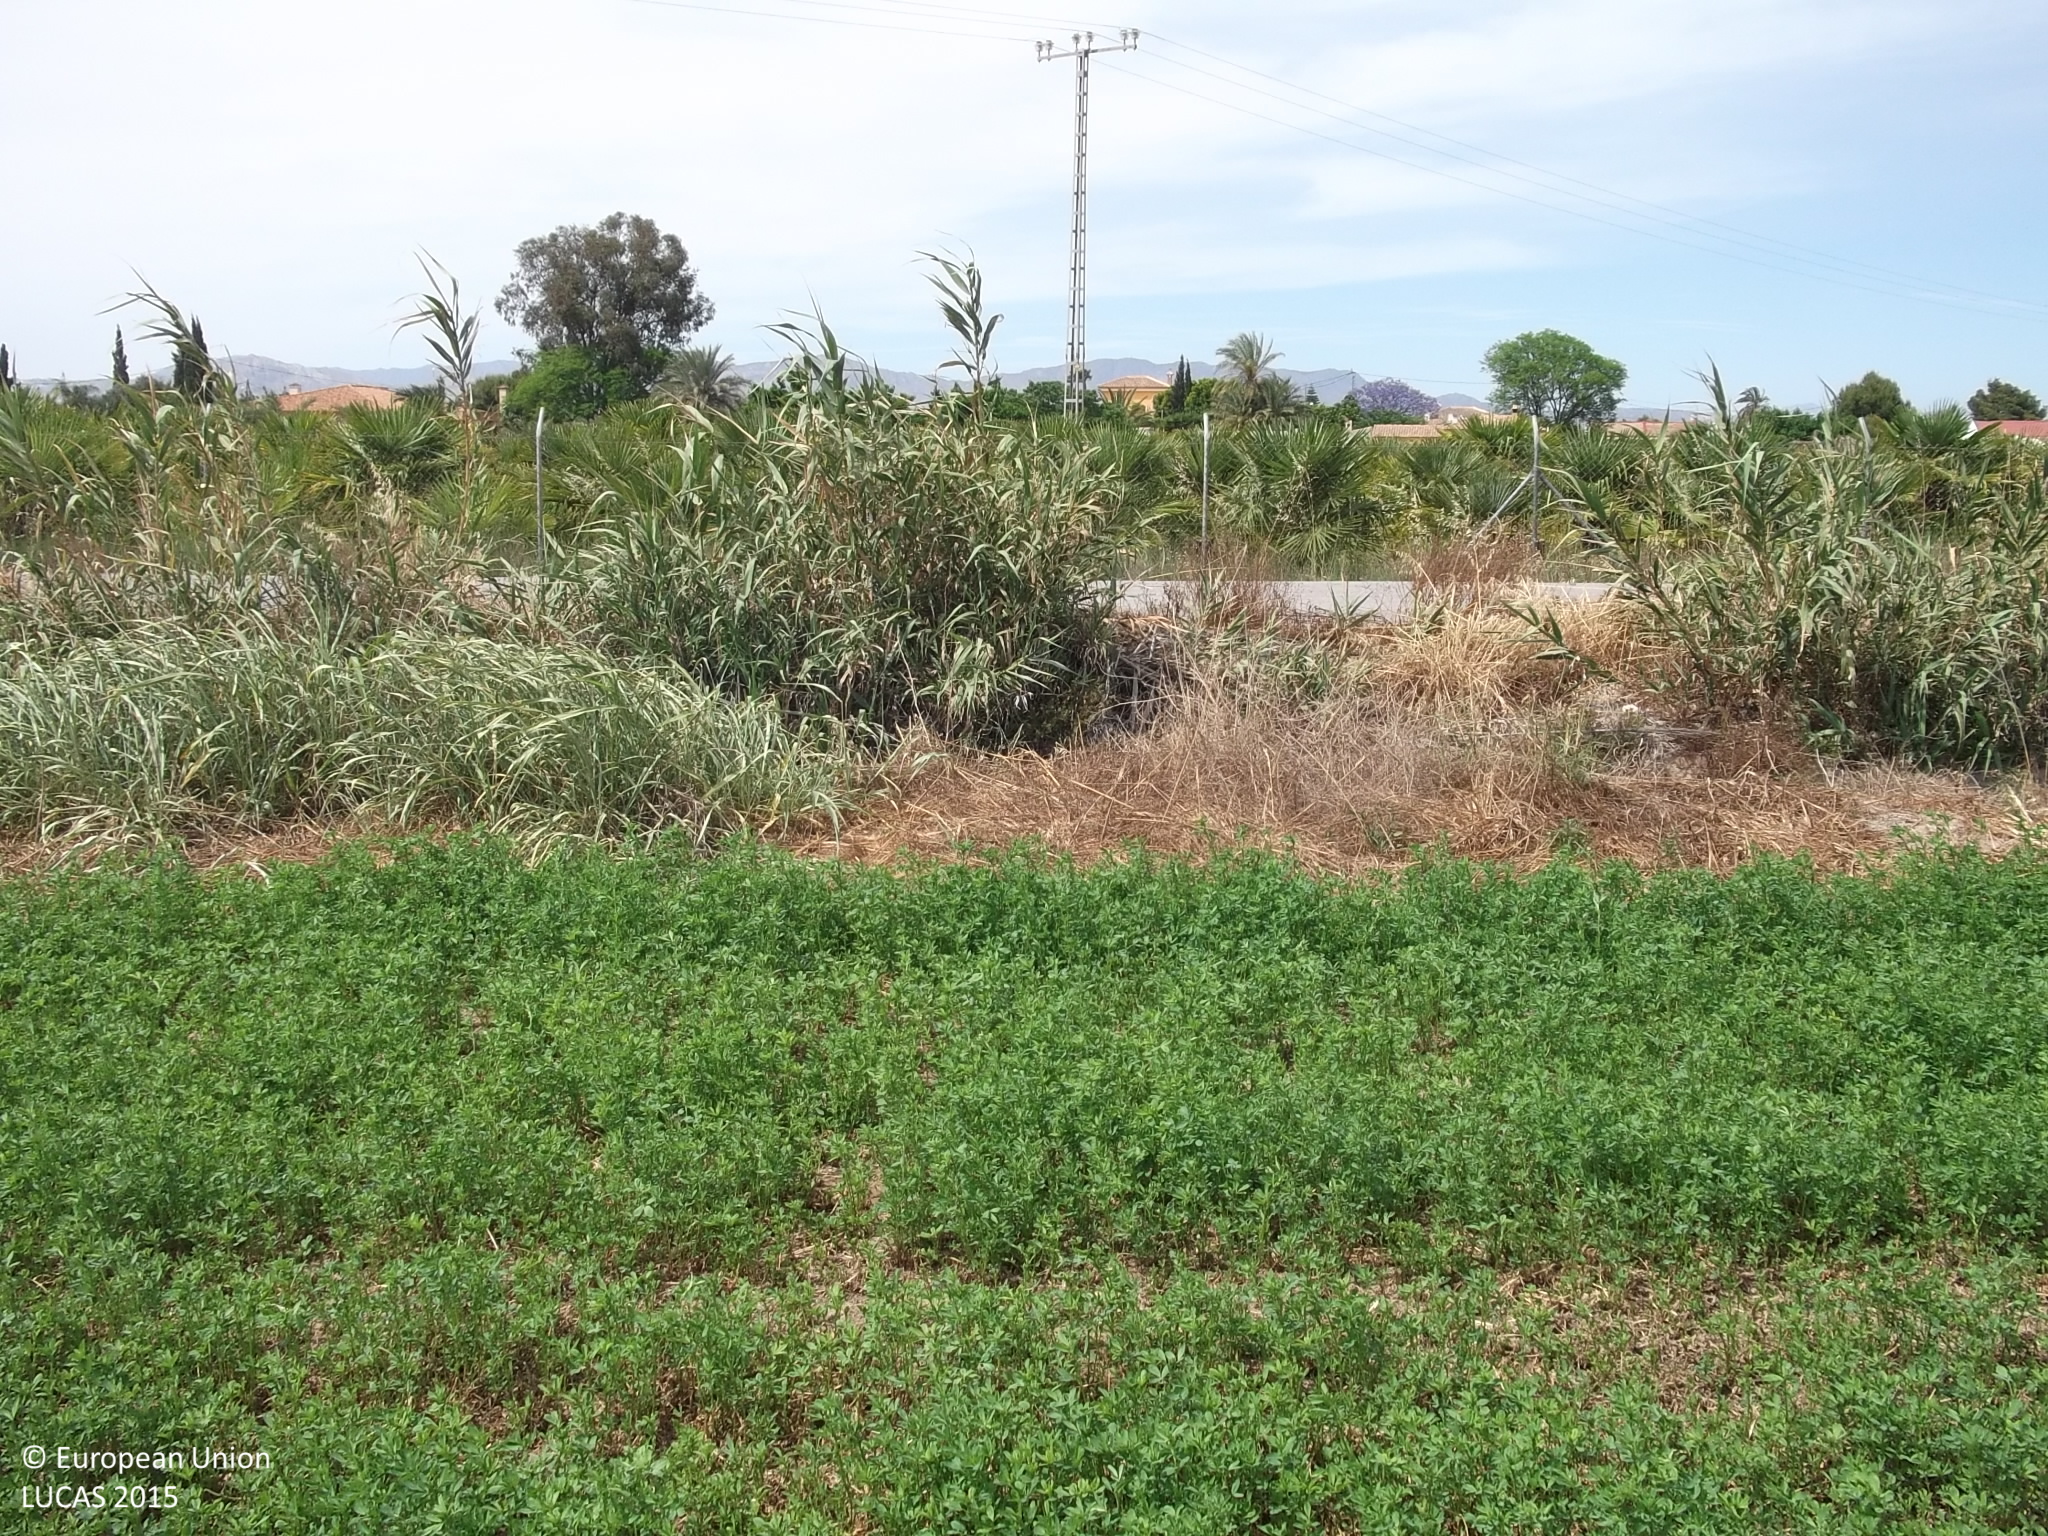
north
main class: Cropland
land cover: Lucerne
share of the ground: > 75 %
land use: Agriculture (excluding fallow land and kitchen gardens)
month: May
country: ES
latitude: 38.1115
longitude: -0.8534
